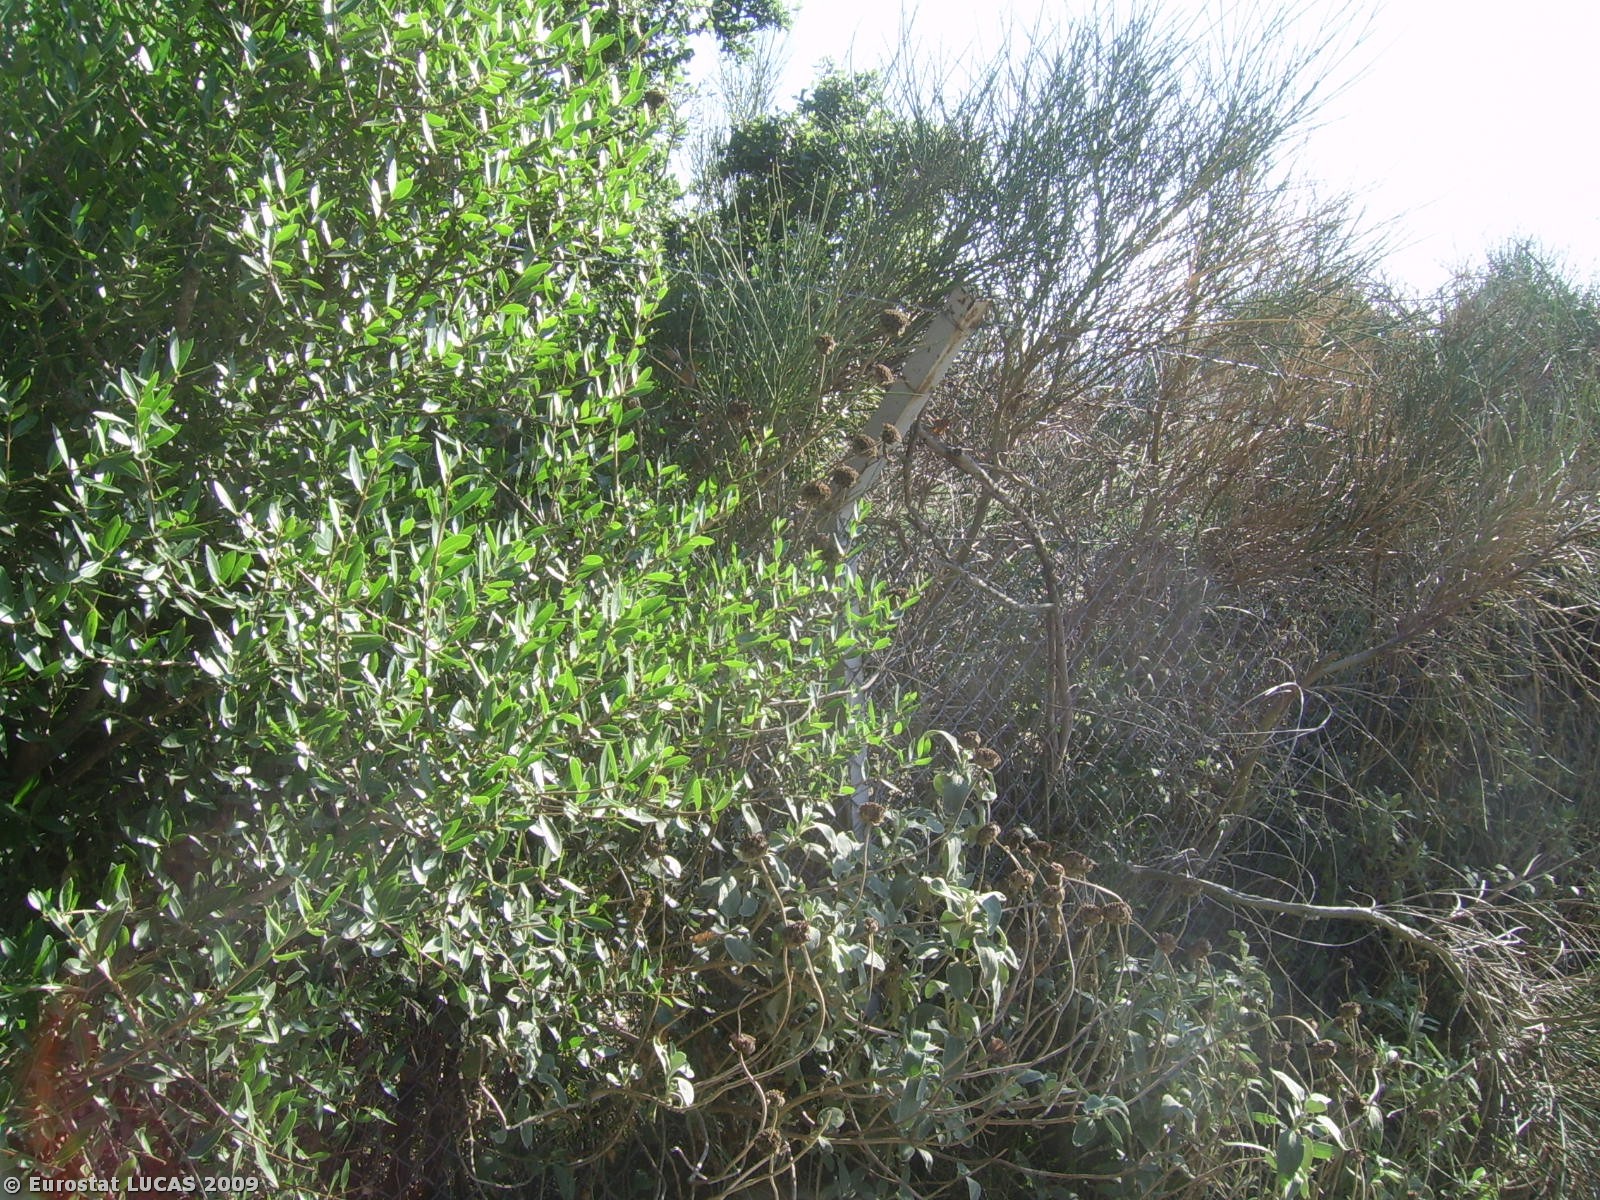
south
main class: Woodland
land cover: Broadleaved woodland
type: hemiboreal forest and nemoral coniferous forest and mixed broadleaved-coniferous forest
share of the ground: > 75 %
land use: Forestry
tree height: > 5 m
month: October
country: GR
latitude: 37.9283
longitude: 21.3268
